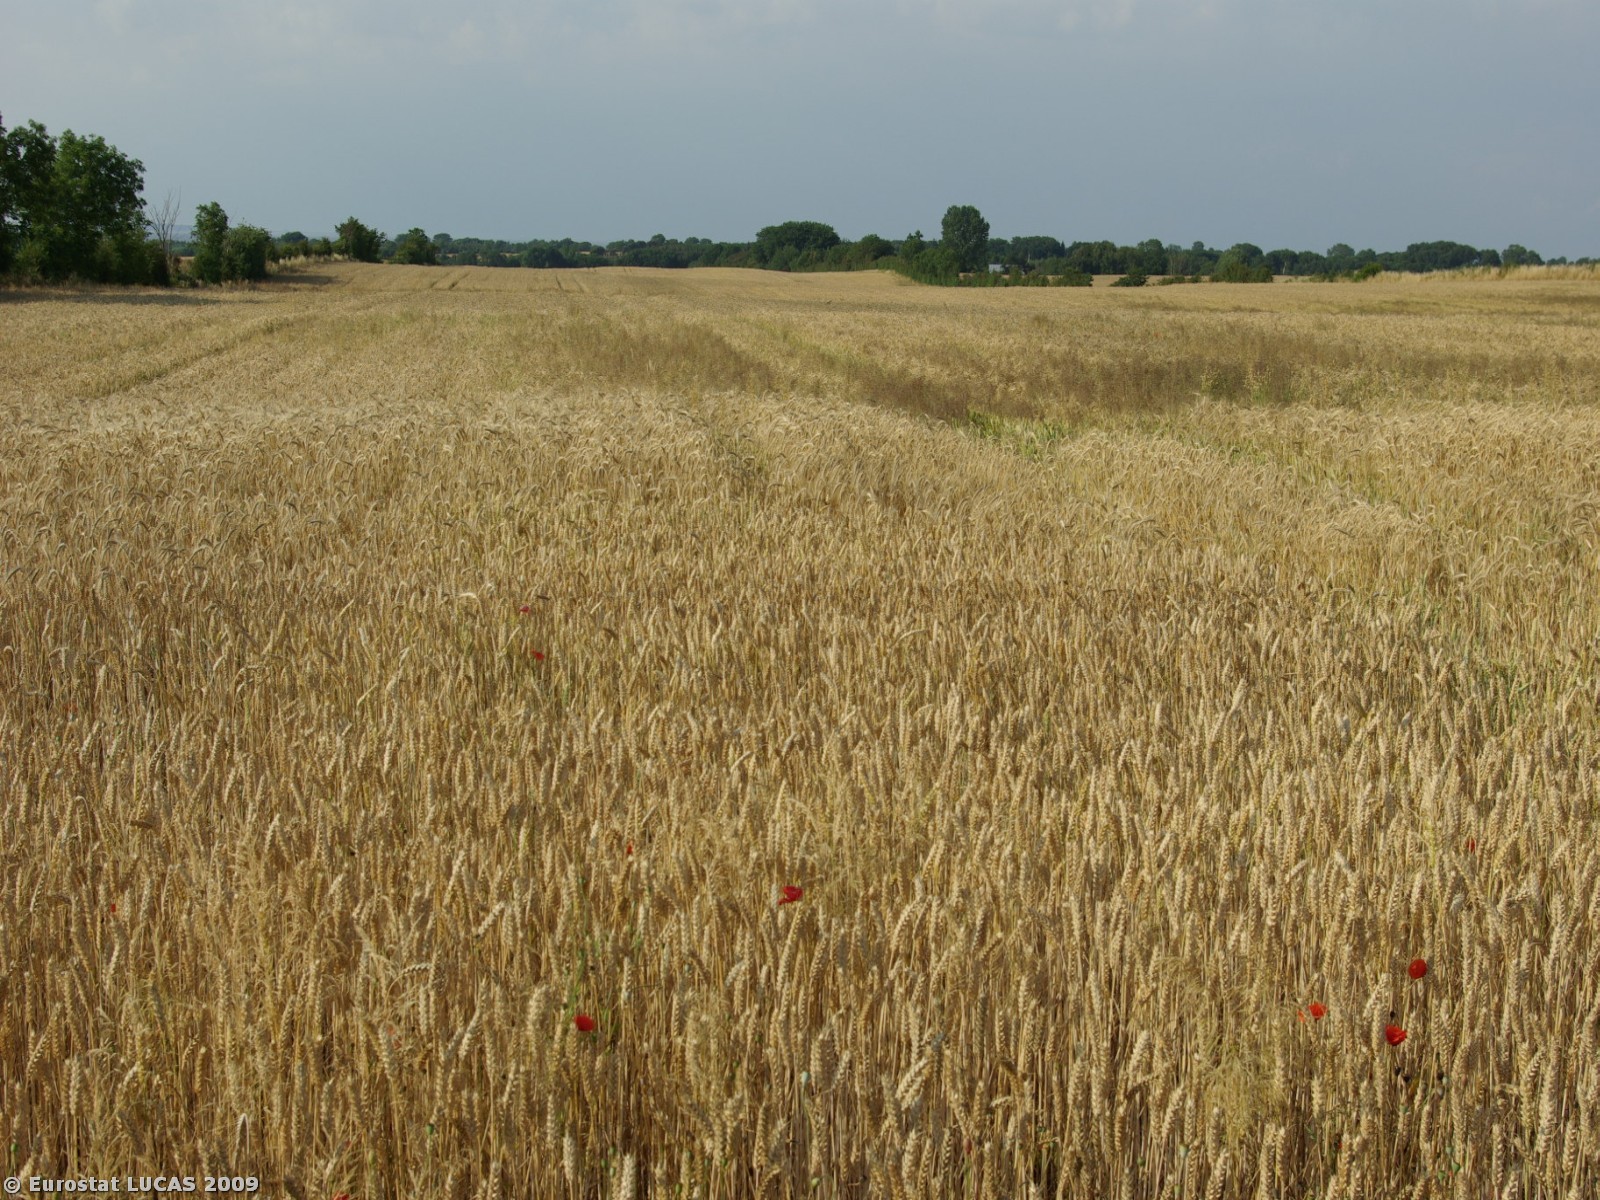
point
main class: Cropland
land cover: Common wheat
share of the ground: > 75 %
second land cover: Triticale
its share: 25 - 50 %
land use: Agriculture (excluding fallow land and kitchen gardens)
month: July
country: DK
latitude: 55.0550
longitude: 9.7028
